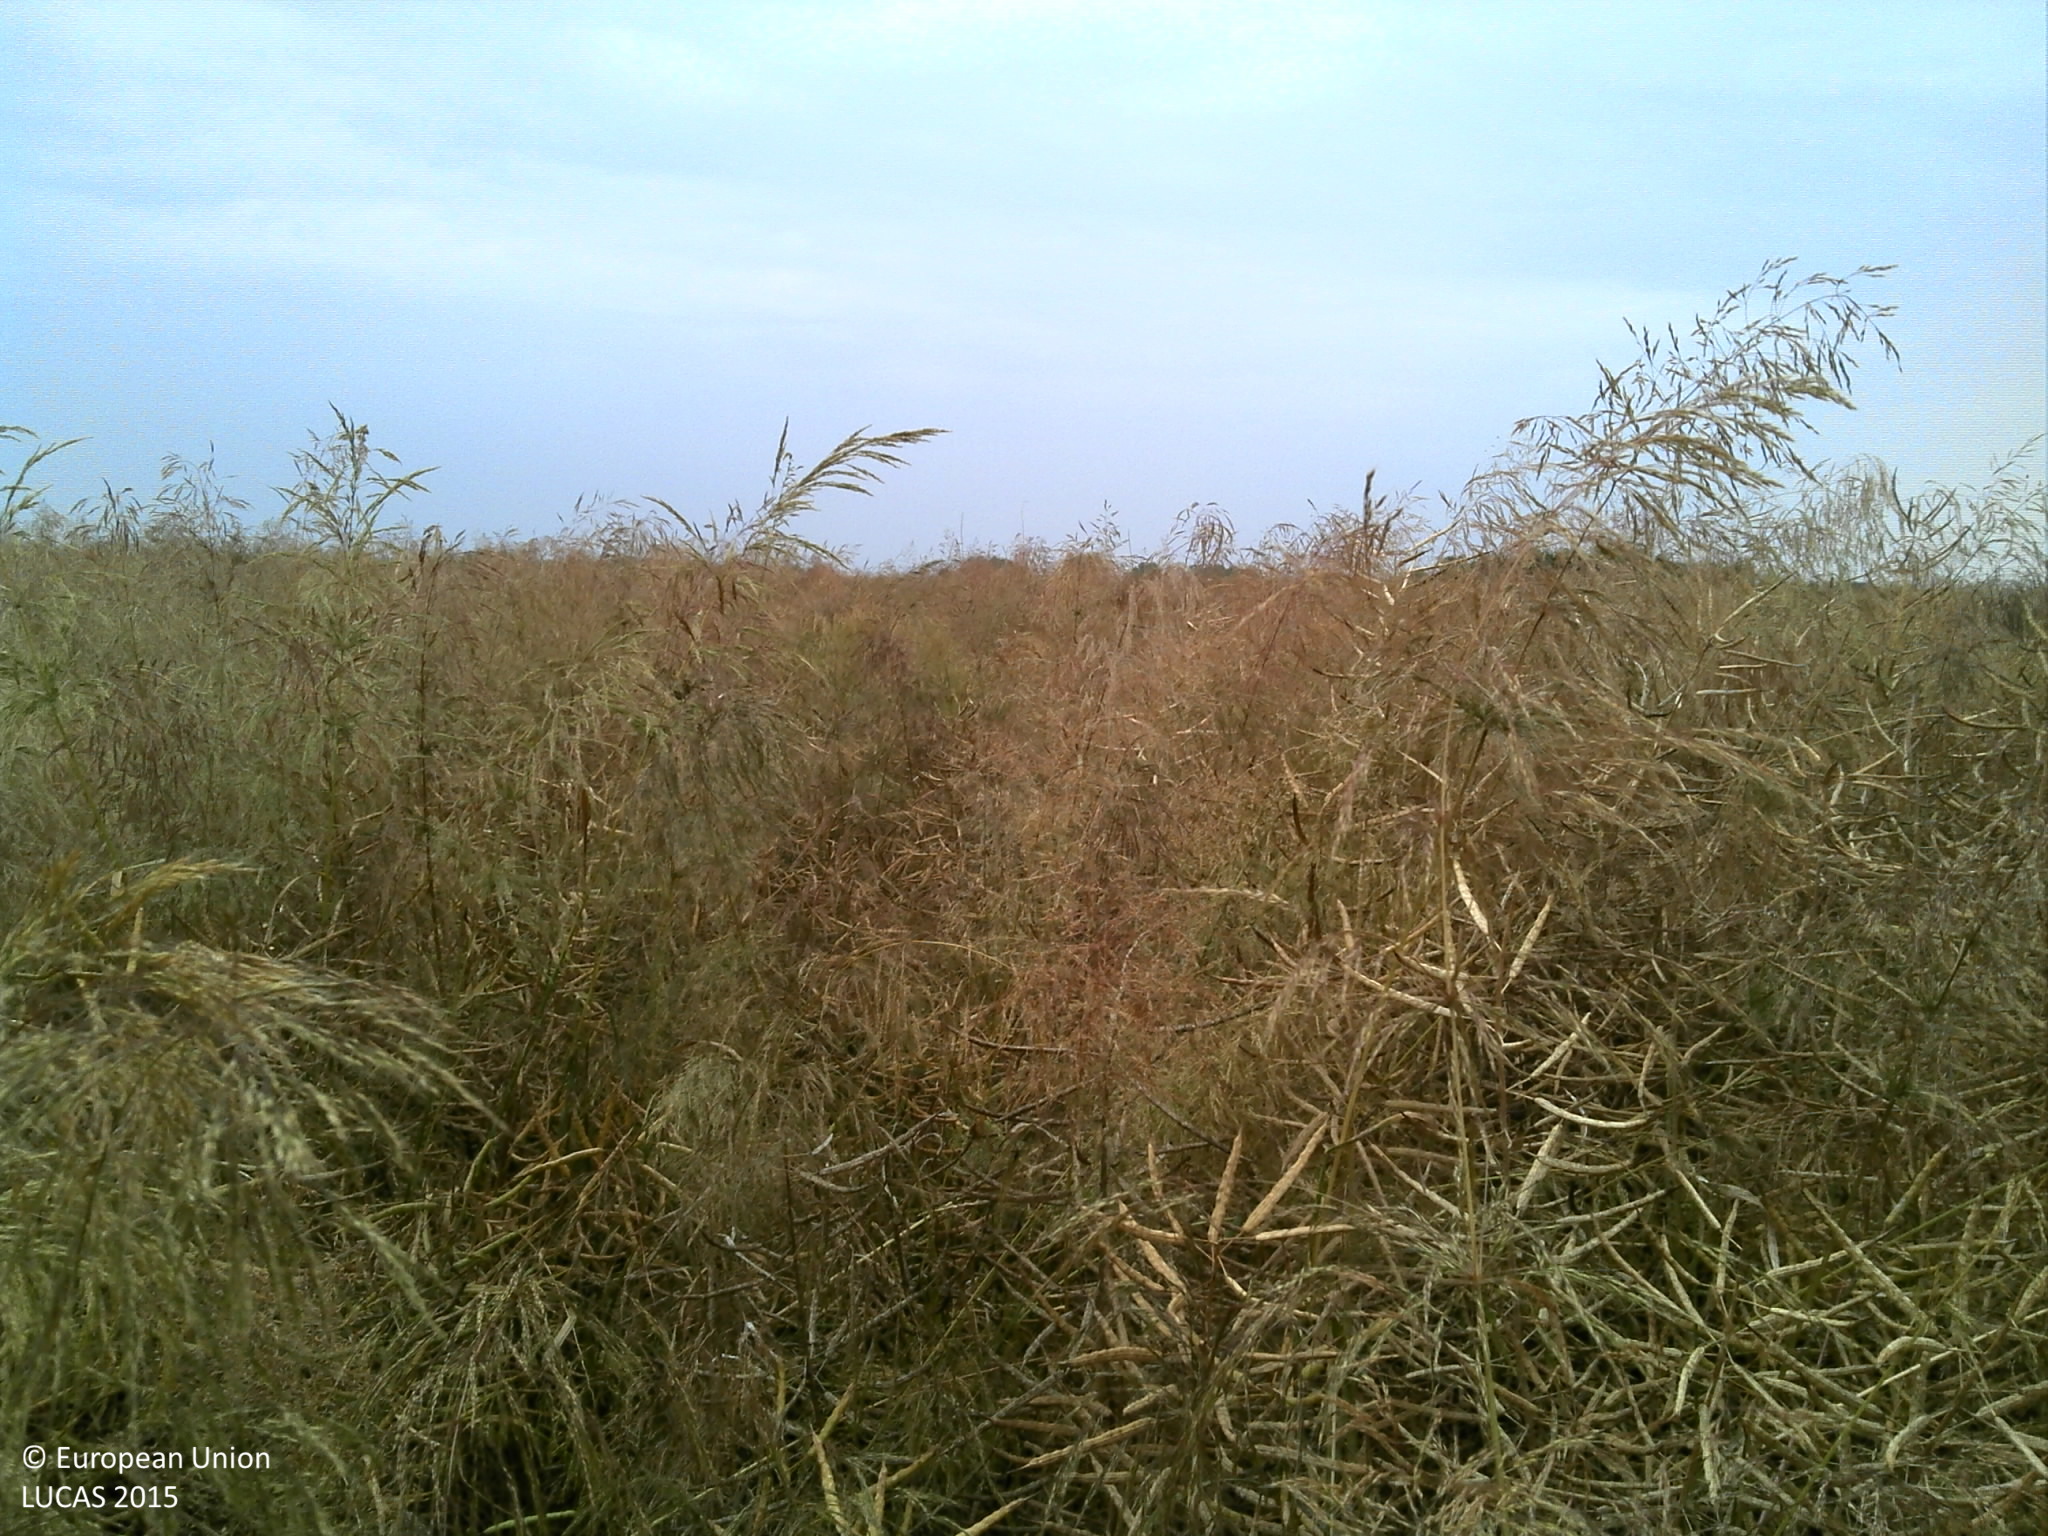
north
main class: Cropland
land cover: Rape and turnip rape
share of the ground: > 75 %
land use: Agriculture (excluding fallow land and kitchen gardens)
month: June
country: HR
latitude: 45.3470
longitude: 18.4418
